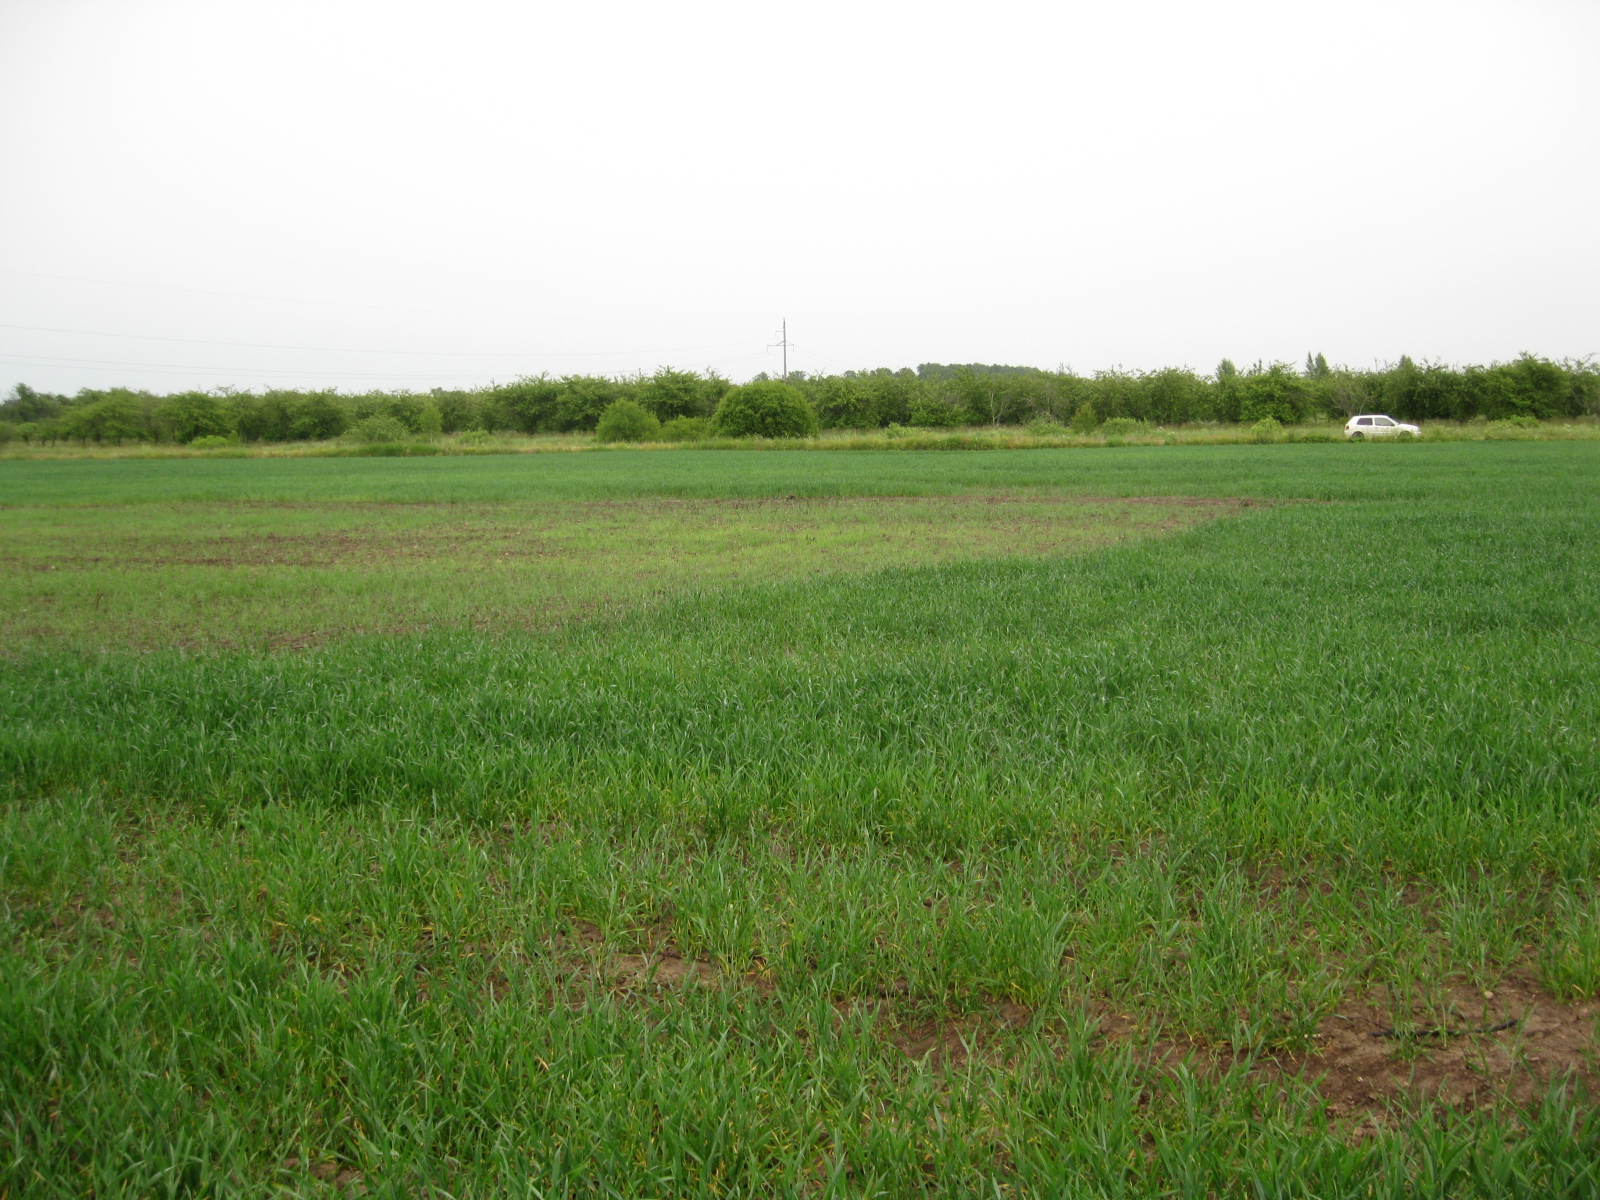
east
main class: Cropland
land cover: Common wheat
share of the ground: > 75 %
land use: Agriculture (excluding fallow land and kitchen gardens)
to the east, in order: Common wheat; Shruby margins; Tracks; Grassland without tree/shrub cover; Ditches and canals; Abandoned hedges; Grassland without tree/shrub cover; Apple fruit
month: June
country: LT
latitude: 55.1684
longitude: 24.0797
